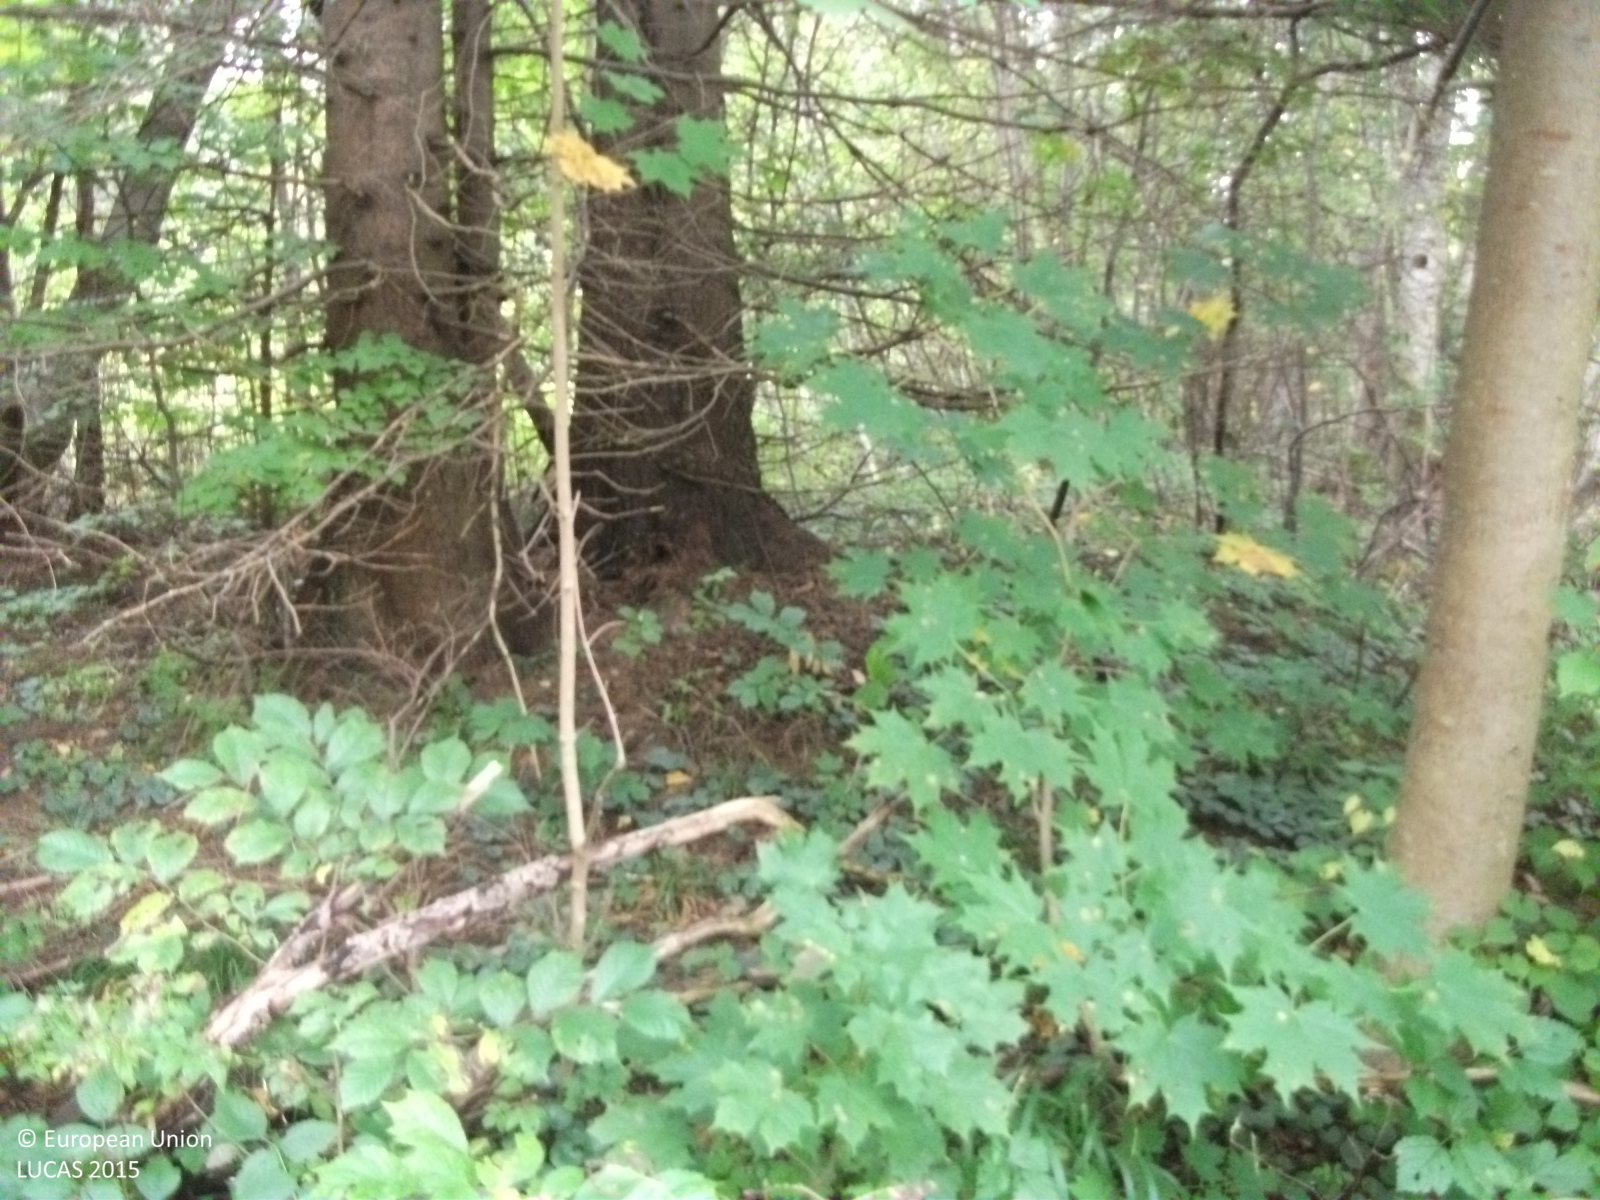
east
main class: Grassland
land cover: Spontaneously vegetated surfaces
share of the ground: > 75 %
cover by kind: herbaceous plants 100 %
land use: Semi-natural and natural areas not in use
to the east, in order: Spontaneously vegetated surfaces; Broadleaved woodland; Inland fresh running water; Broadleaved woodland; Electric lines; Broadleaved woodland; Spontaneously vegetated surfaces; Broadleaved woodland; Inland fresh running water; Broadleaved woodland
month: September
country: LV
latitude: 57.6525
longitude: 24.4500
